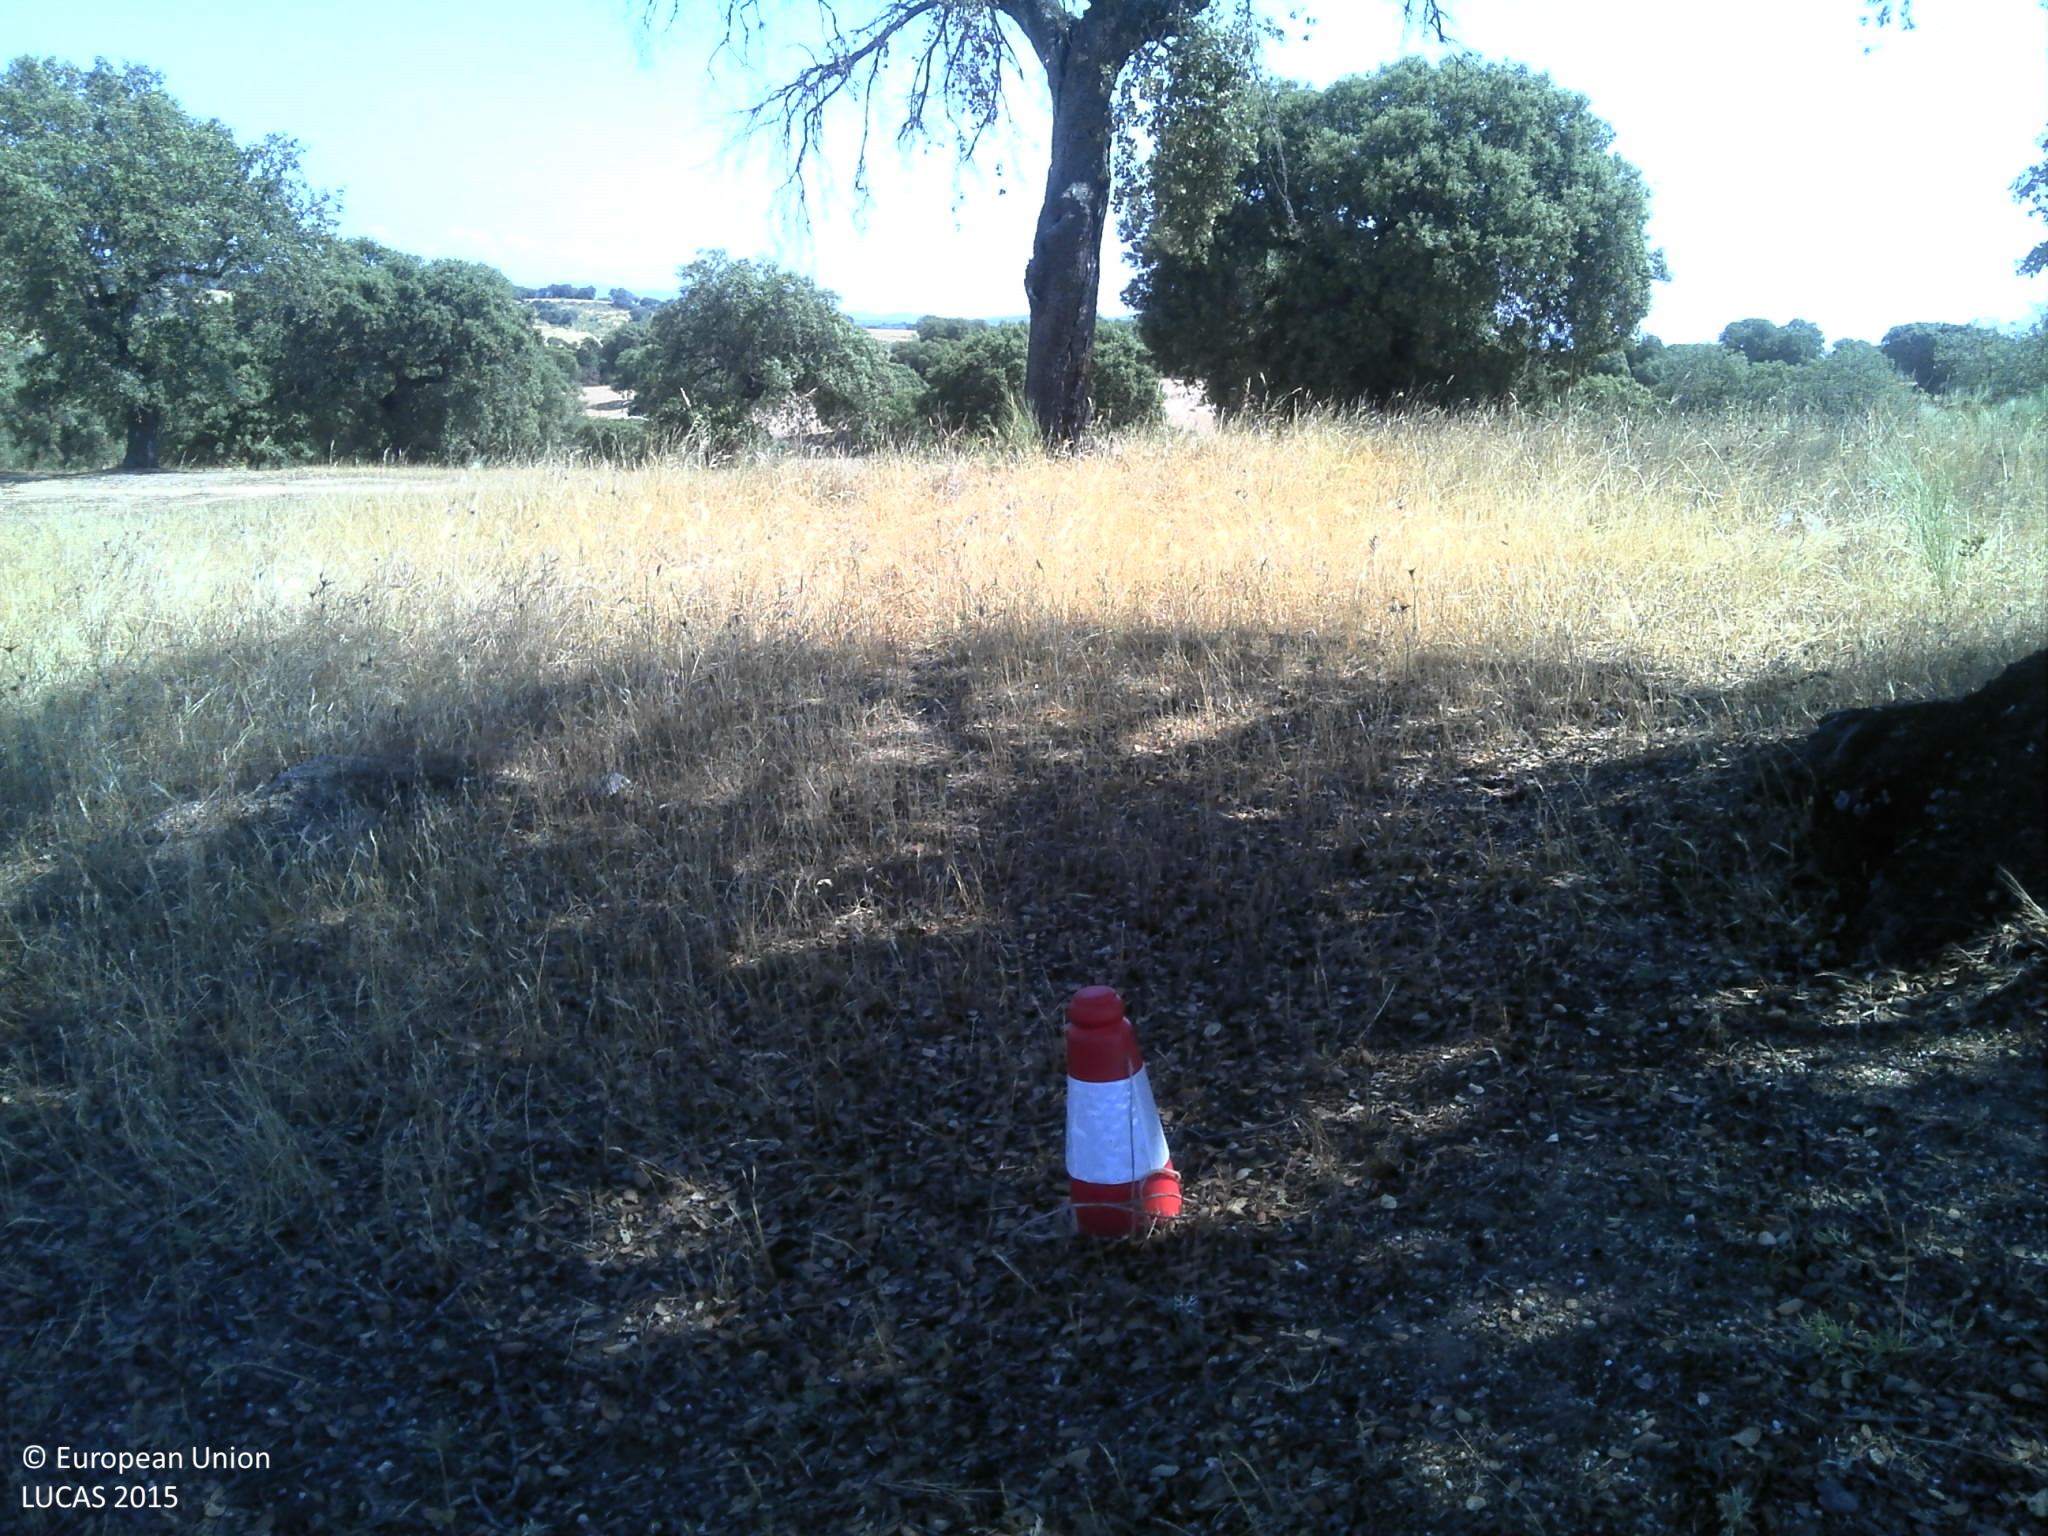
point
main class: Woodland
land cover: Broadleaved woodland
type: broadleaved evergreen forest
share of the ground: 25 - 50 %
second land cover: Spontaneously vegetated surfaces
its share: 25 - 50 %
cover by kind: broadleaved forest trees 40 %, herbaceous plants 30 %, unconsolidated bare surface 25 %
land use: Forestry
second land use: Agriculture (excluding fallow land and kitchen gardens)
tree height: > 5 m
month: June
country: PT
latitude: 39.8820
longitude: -7.0805
